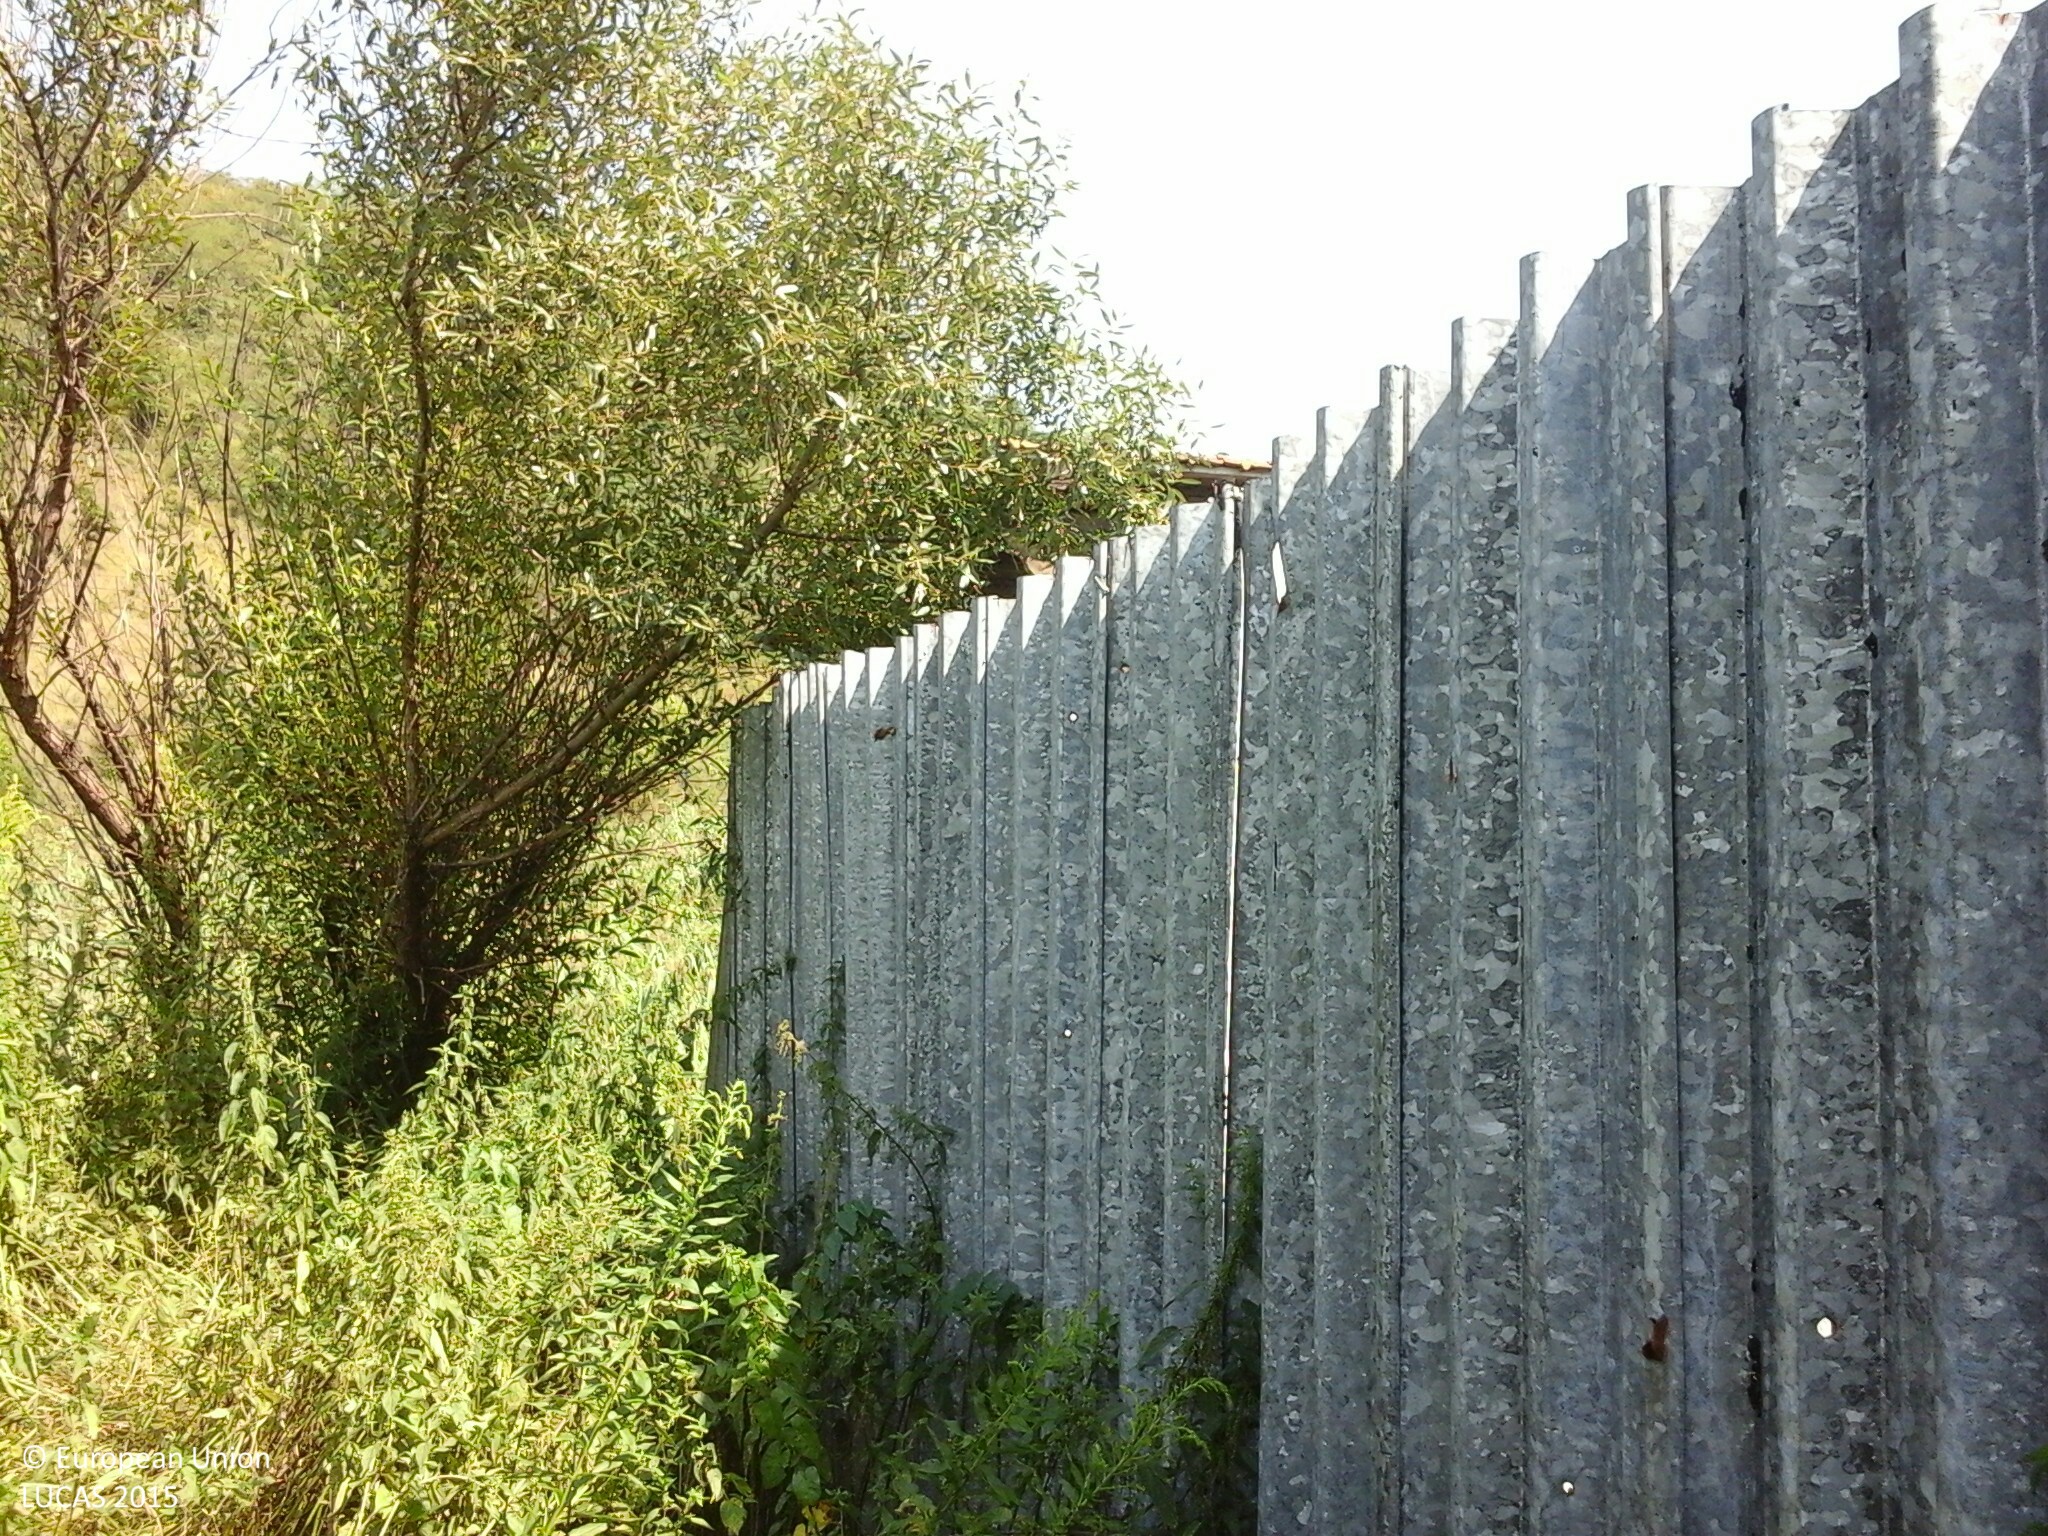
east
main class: Grassland
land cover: Grassland with sparse tree/shrub cover
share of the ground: > 75 %
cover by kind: herbaceous plants 95 %, broadleaved forest trees 5 %
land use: Semi-natural and natural areas not in use
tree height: < 5 m
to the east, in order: Grassland with sparse tree/shrub cover; Artificial constructions in urban areas; Inland marshes; Ditches and canals; Grassland without tree/shrub cover; Paved roads, cycling and walking lanes; Electric lines; Grassland with sparse tree/shrub cover; Shrubland without tree cover; Broadleaved woodland
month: August
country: HU
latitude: 48.1658
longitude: 20.3992
